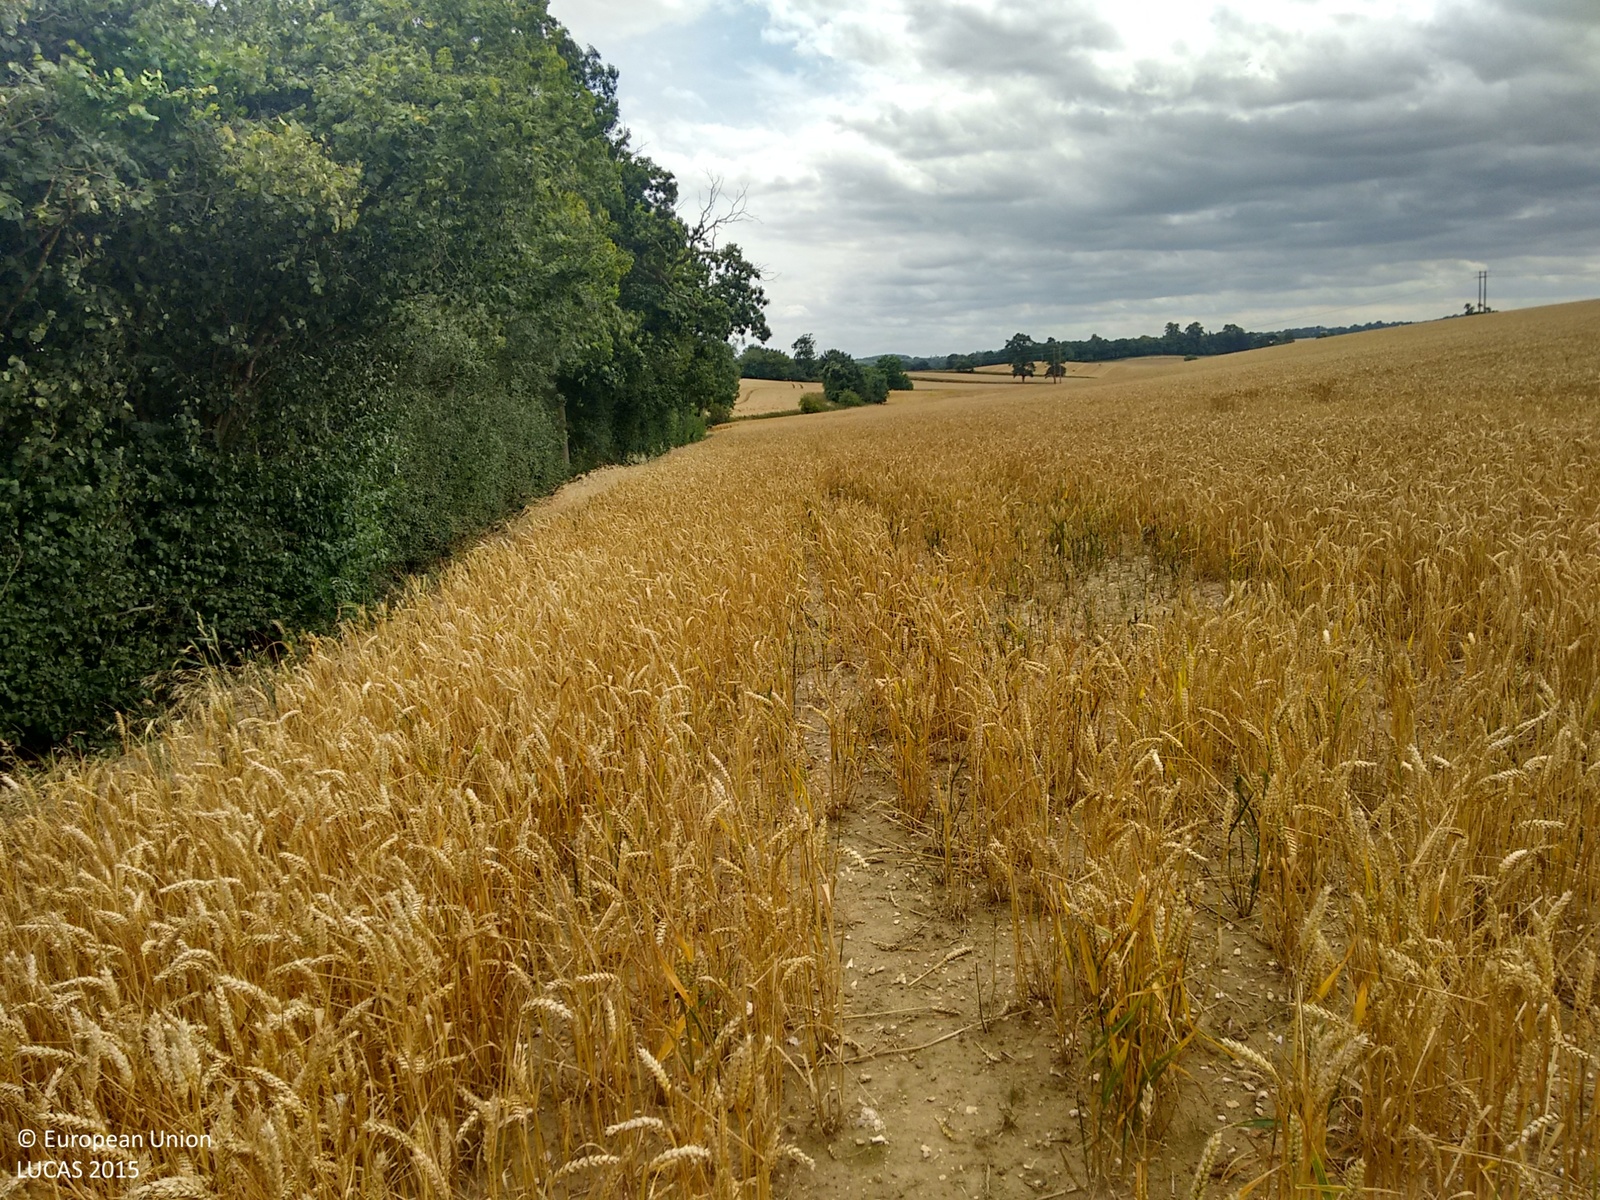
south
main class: Cropland
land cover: Common wheat
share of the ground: 50 - 75 %
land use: Agriculture (excluding fallow land and kitchen gardens)
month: August
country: GB
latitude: 51.9594
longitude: 0.4985
